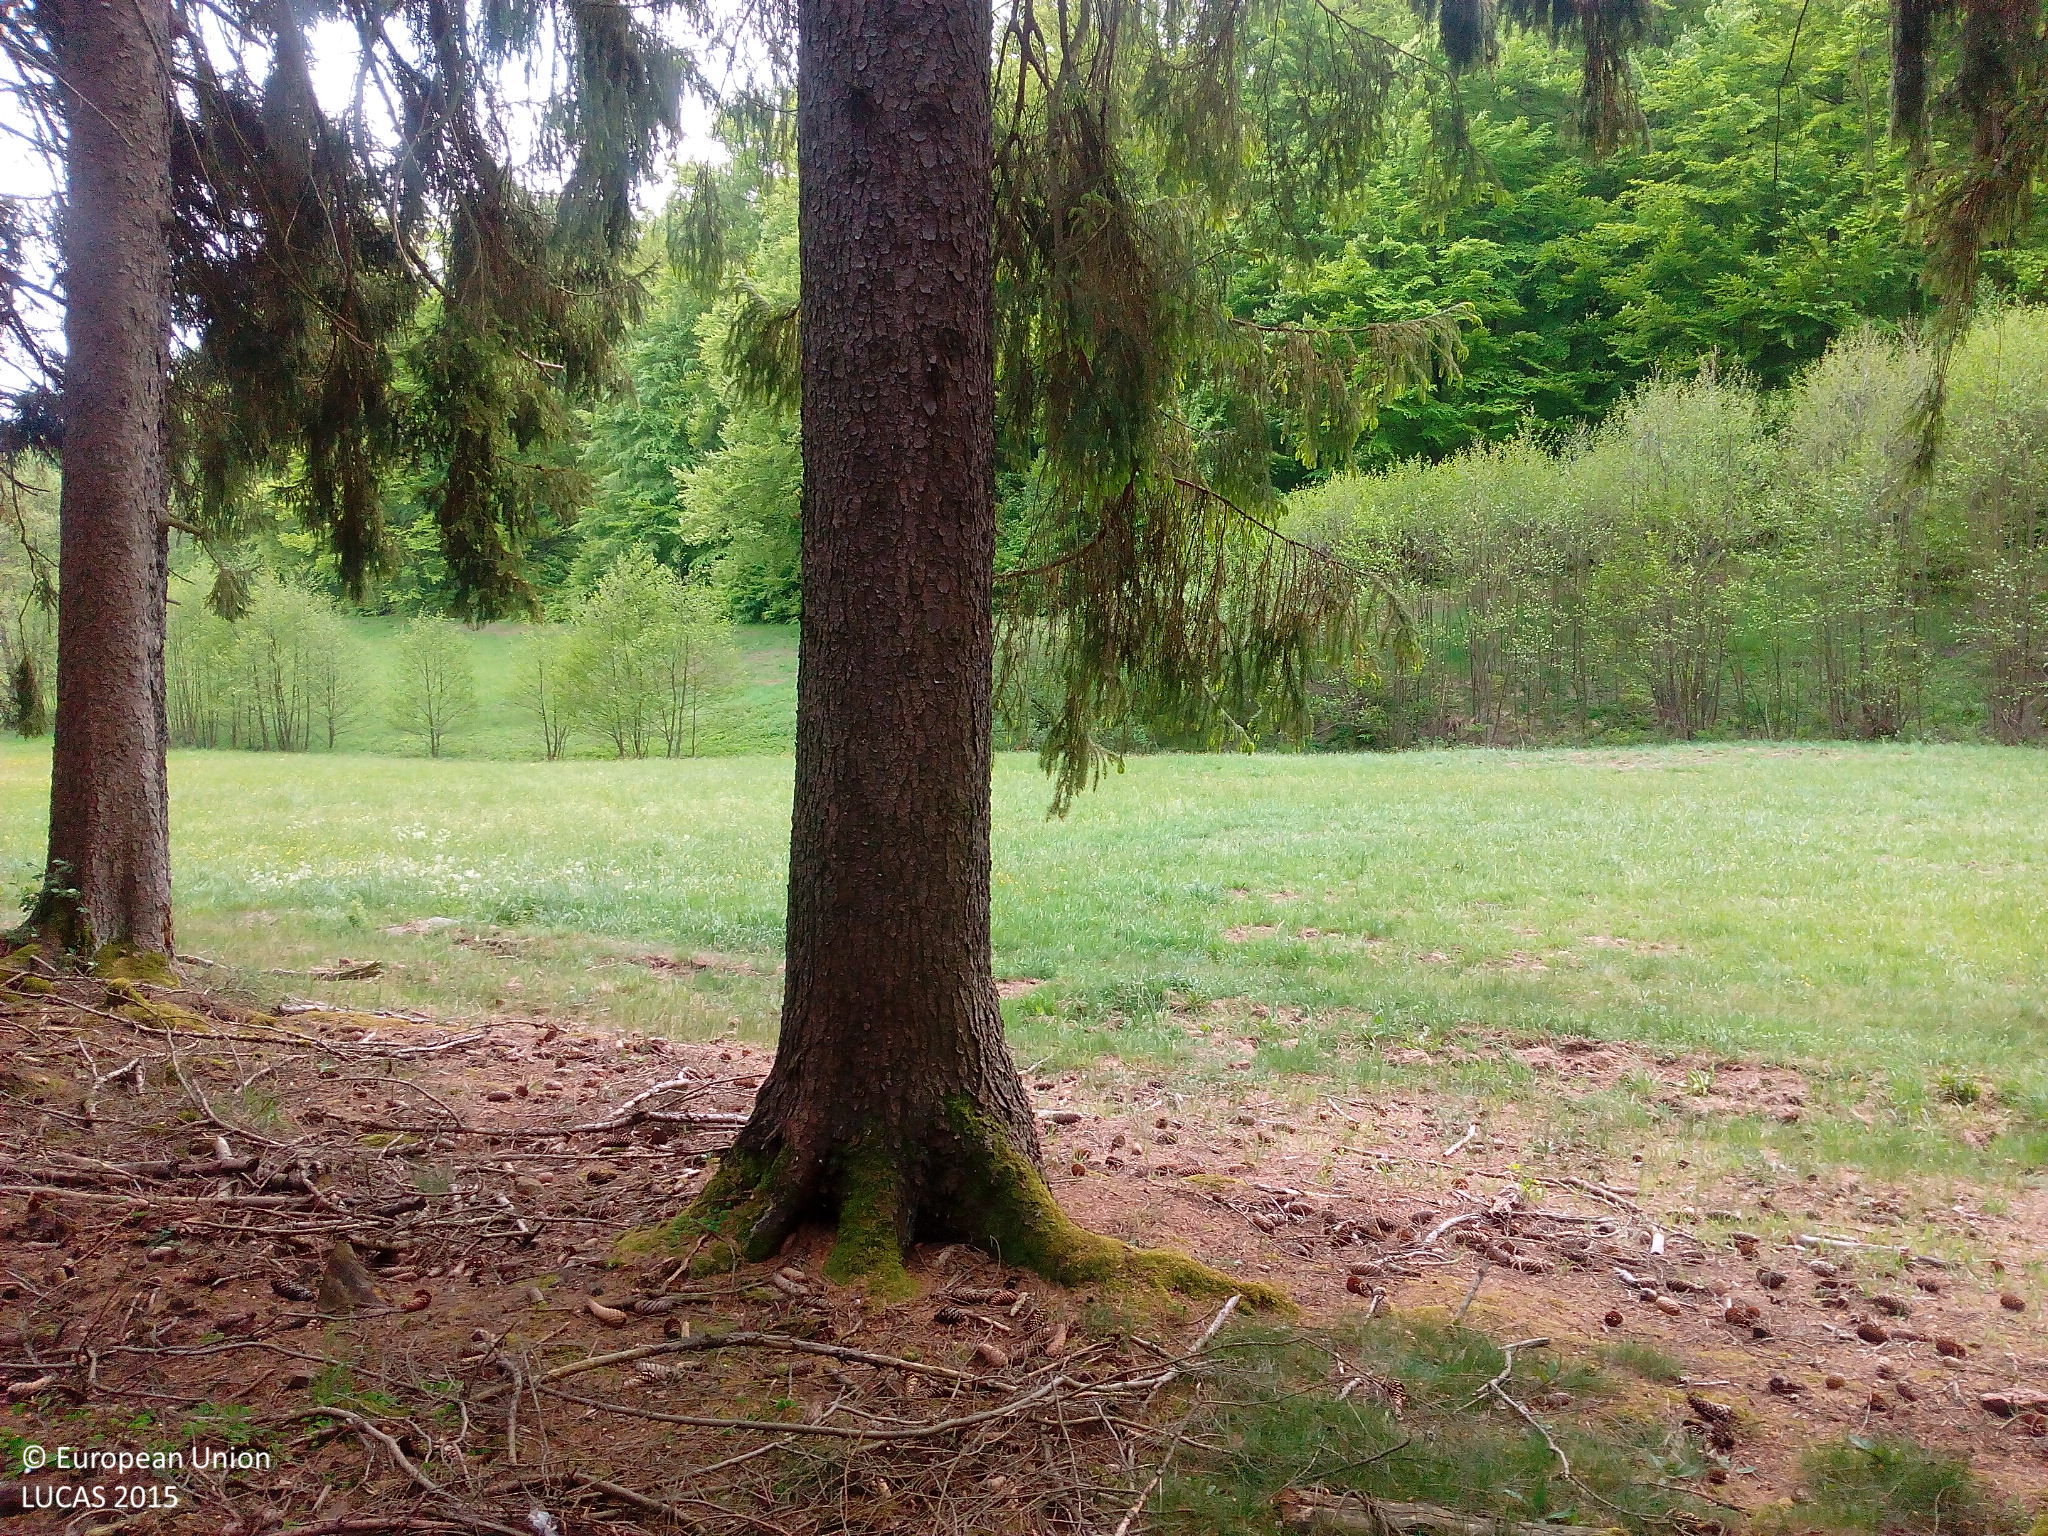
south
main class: Woodland
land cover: Spruce dominated coniferous woodland
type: hemiboreal forest and nemoral coniferous forest and mixed broadleaved-coniferous forest
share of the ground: > 75 %
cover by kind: coniferous forest trees 60 %, unconsolidated bare surface 35 %, lichens and mosses 5 %
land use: Forestry
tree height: > 5 m
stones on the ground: < 10 %
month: May
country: DE
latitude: 51.1910
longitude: 9.8713
